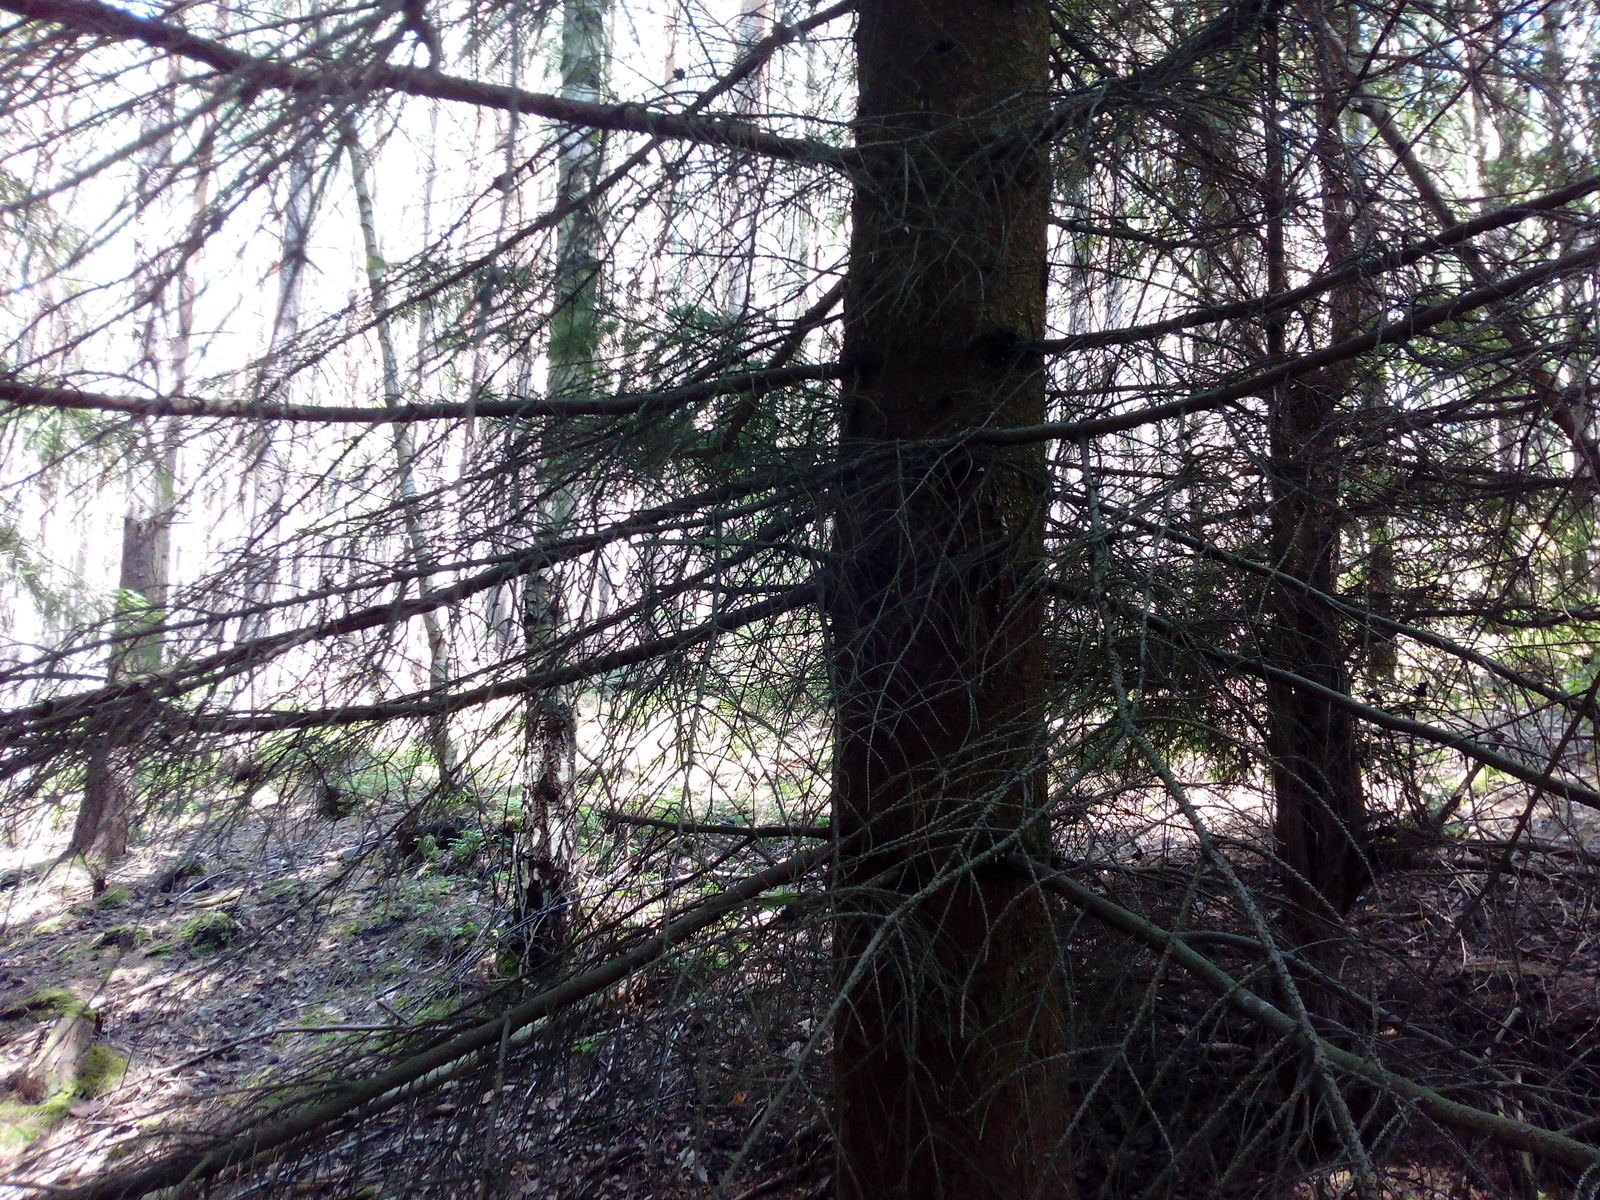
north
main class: Woodland
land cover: Spruce dominated coniferous woodland
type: hemiboreal forest and nemoral coniferous forest and mixed broadleaved-coniferous forest
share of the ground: > 75 %
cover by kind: coniferous forest trees 100 %
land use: Forestry
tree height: > 5 m
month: June
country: DE
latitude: 50.7018
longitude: 10.9484
